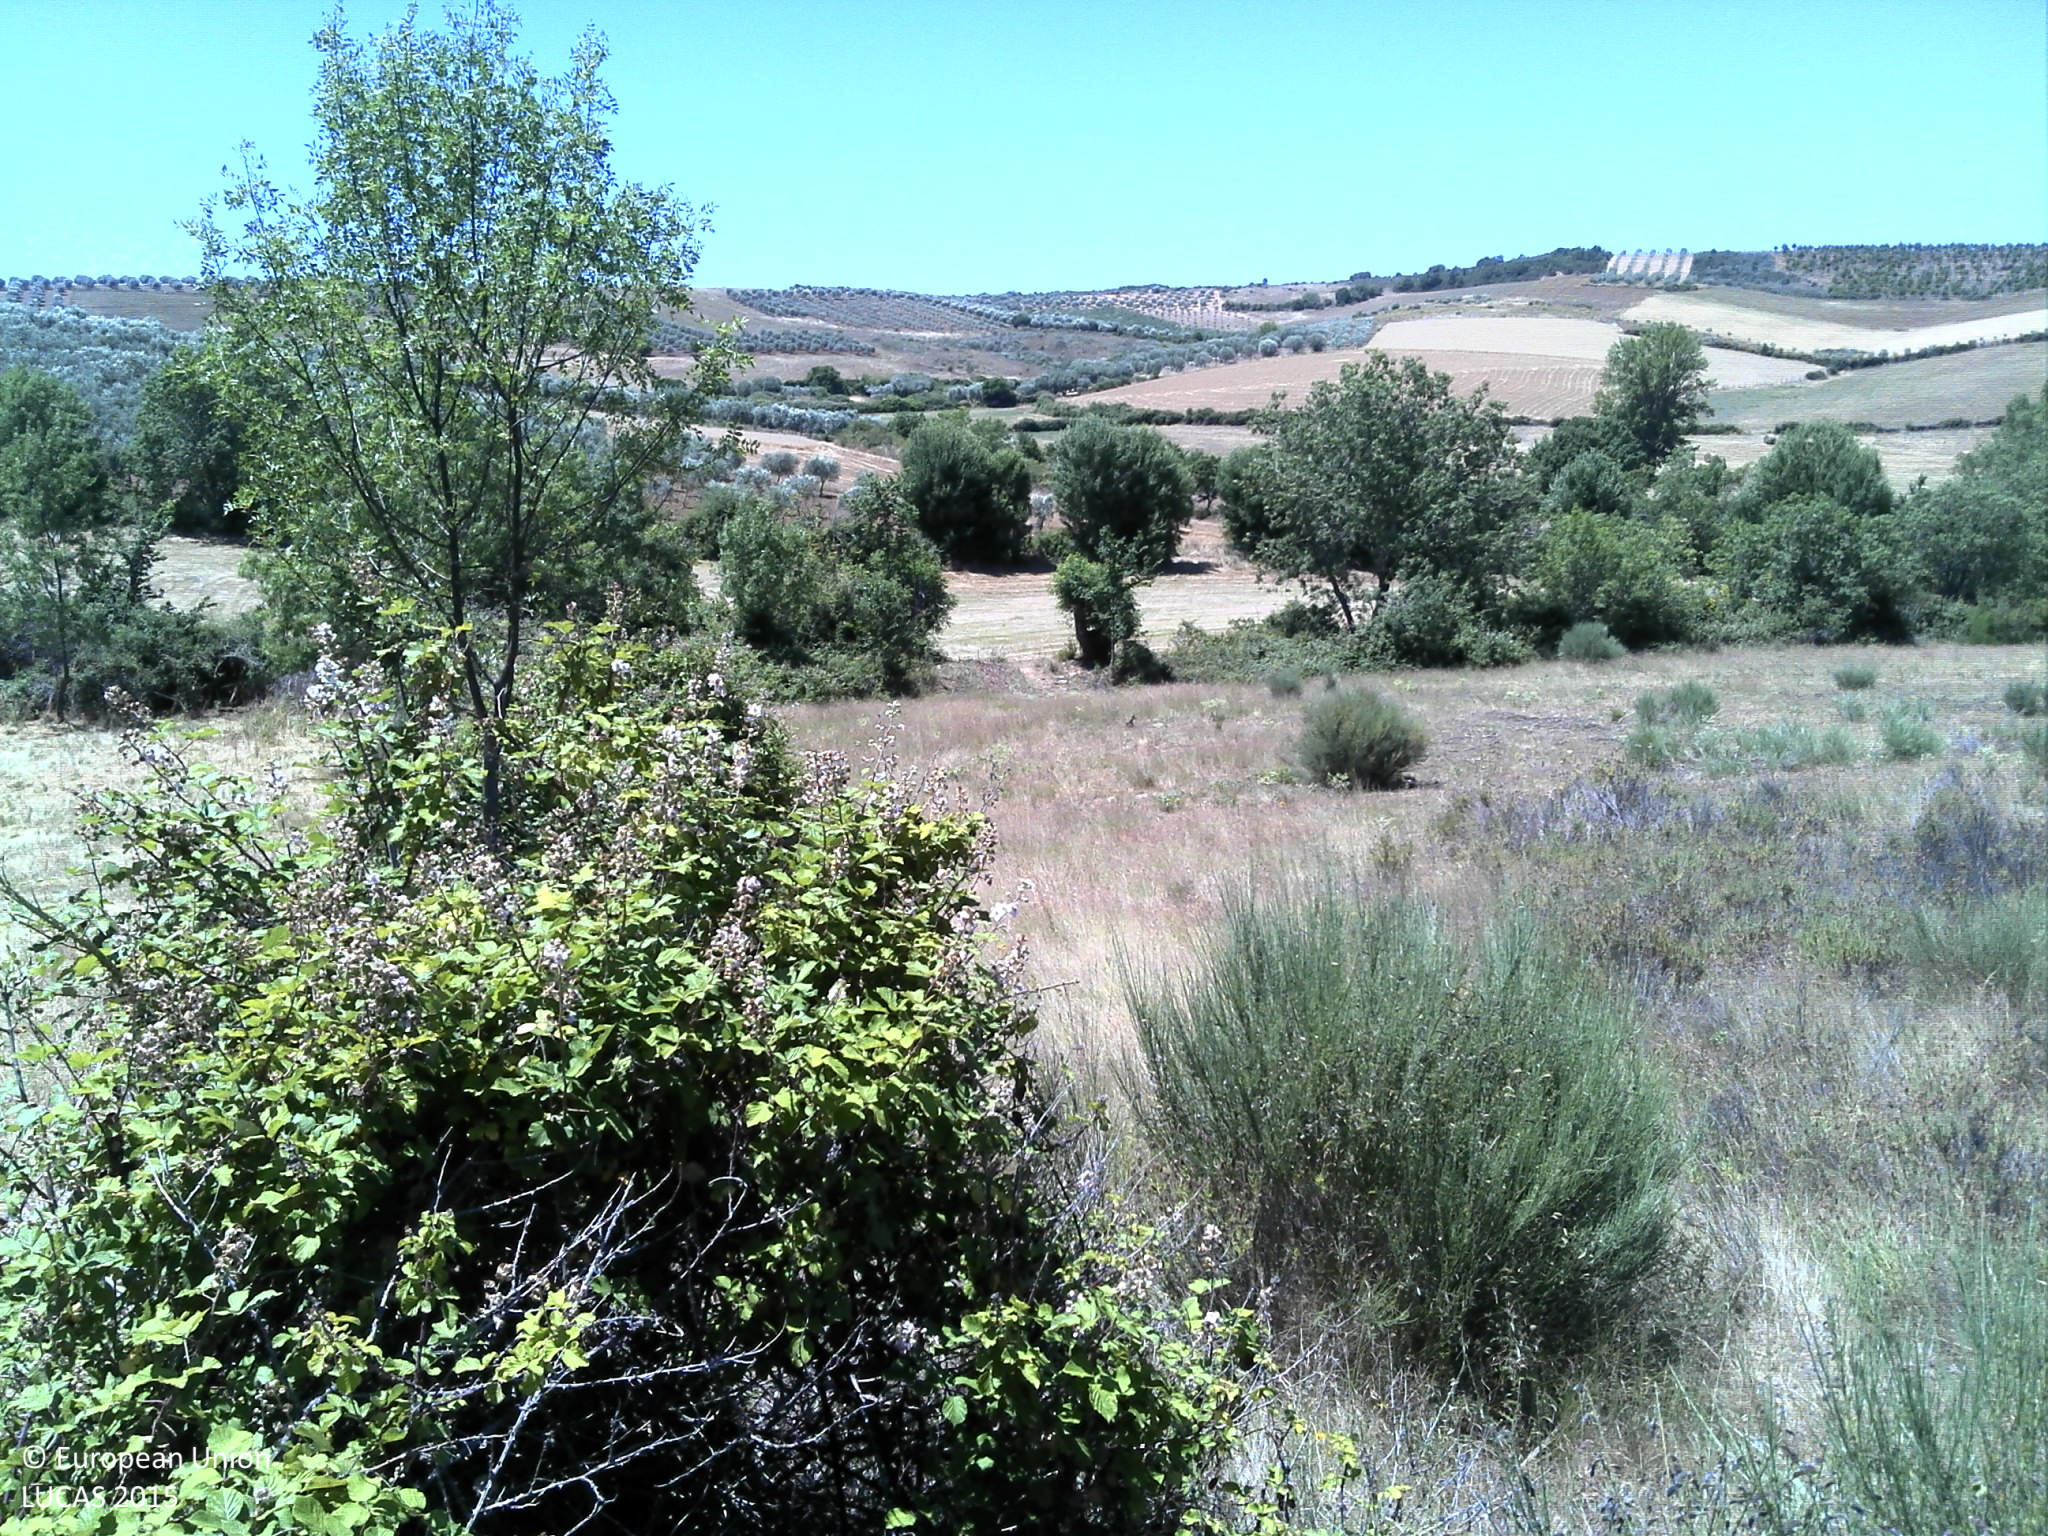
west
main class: Grassland
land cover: Grassland without tree/shrub cover
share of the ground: > 75 %
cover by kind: herbaceous plants 100 %
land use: Agriculture (excluding fallow land and kitchen gardens)
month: June
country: PT
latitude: 41.4787
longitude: -7.0120
